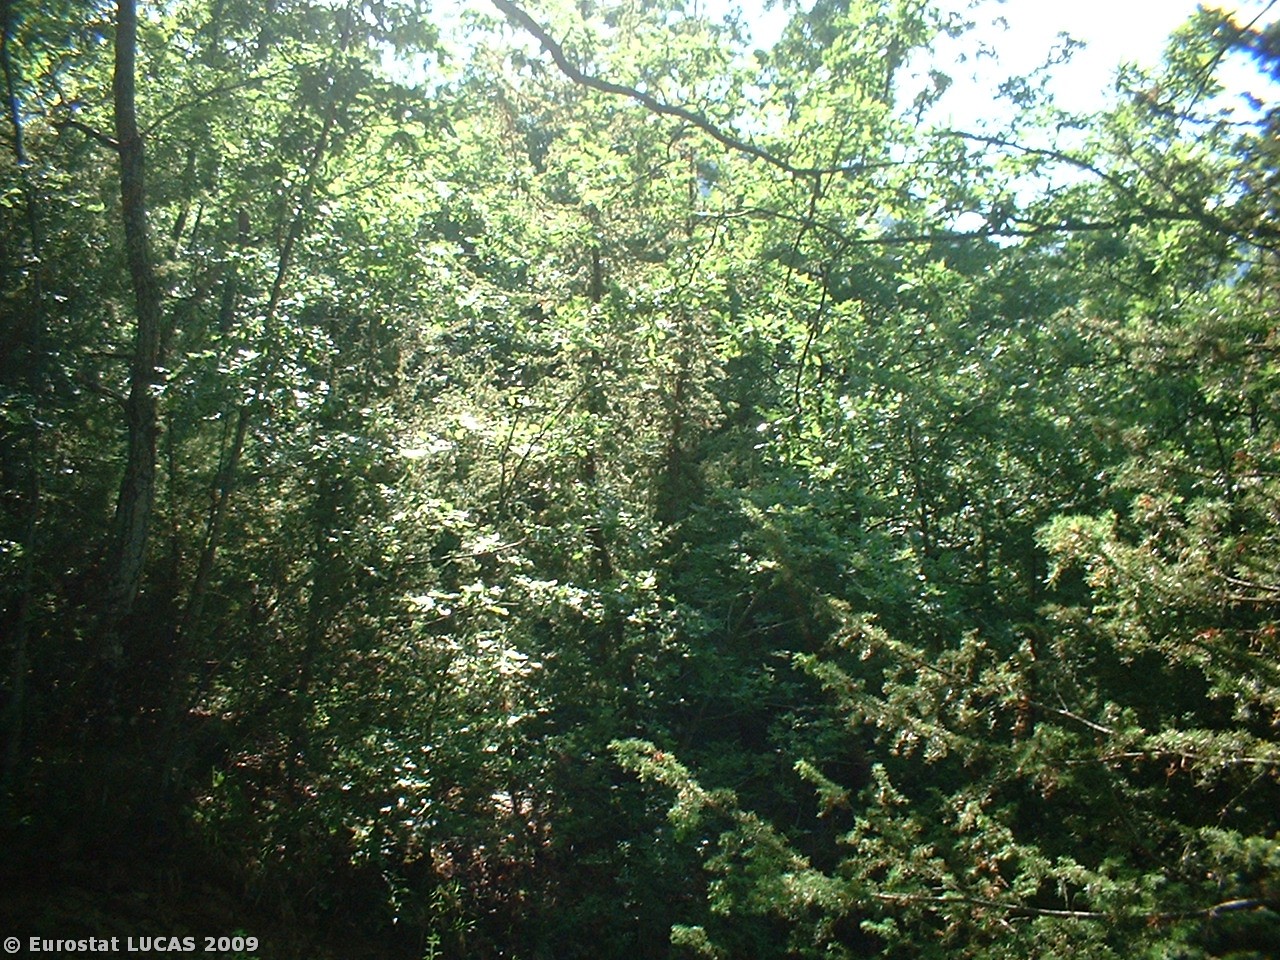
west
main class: Woodland
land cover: Broadleaved woodland
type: mesophytic deciduous forest
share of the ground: > 75 %
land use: Forestry
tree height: > 5 m
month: June
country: IT
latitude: 42.7284
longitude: 13.2512
